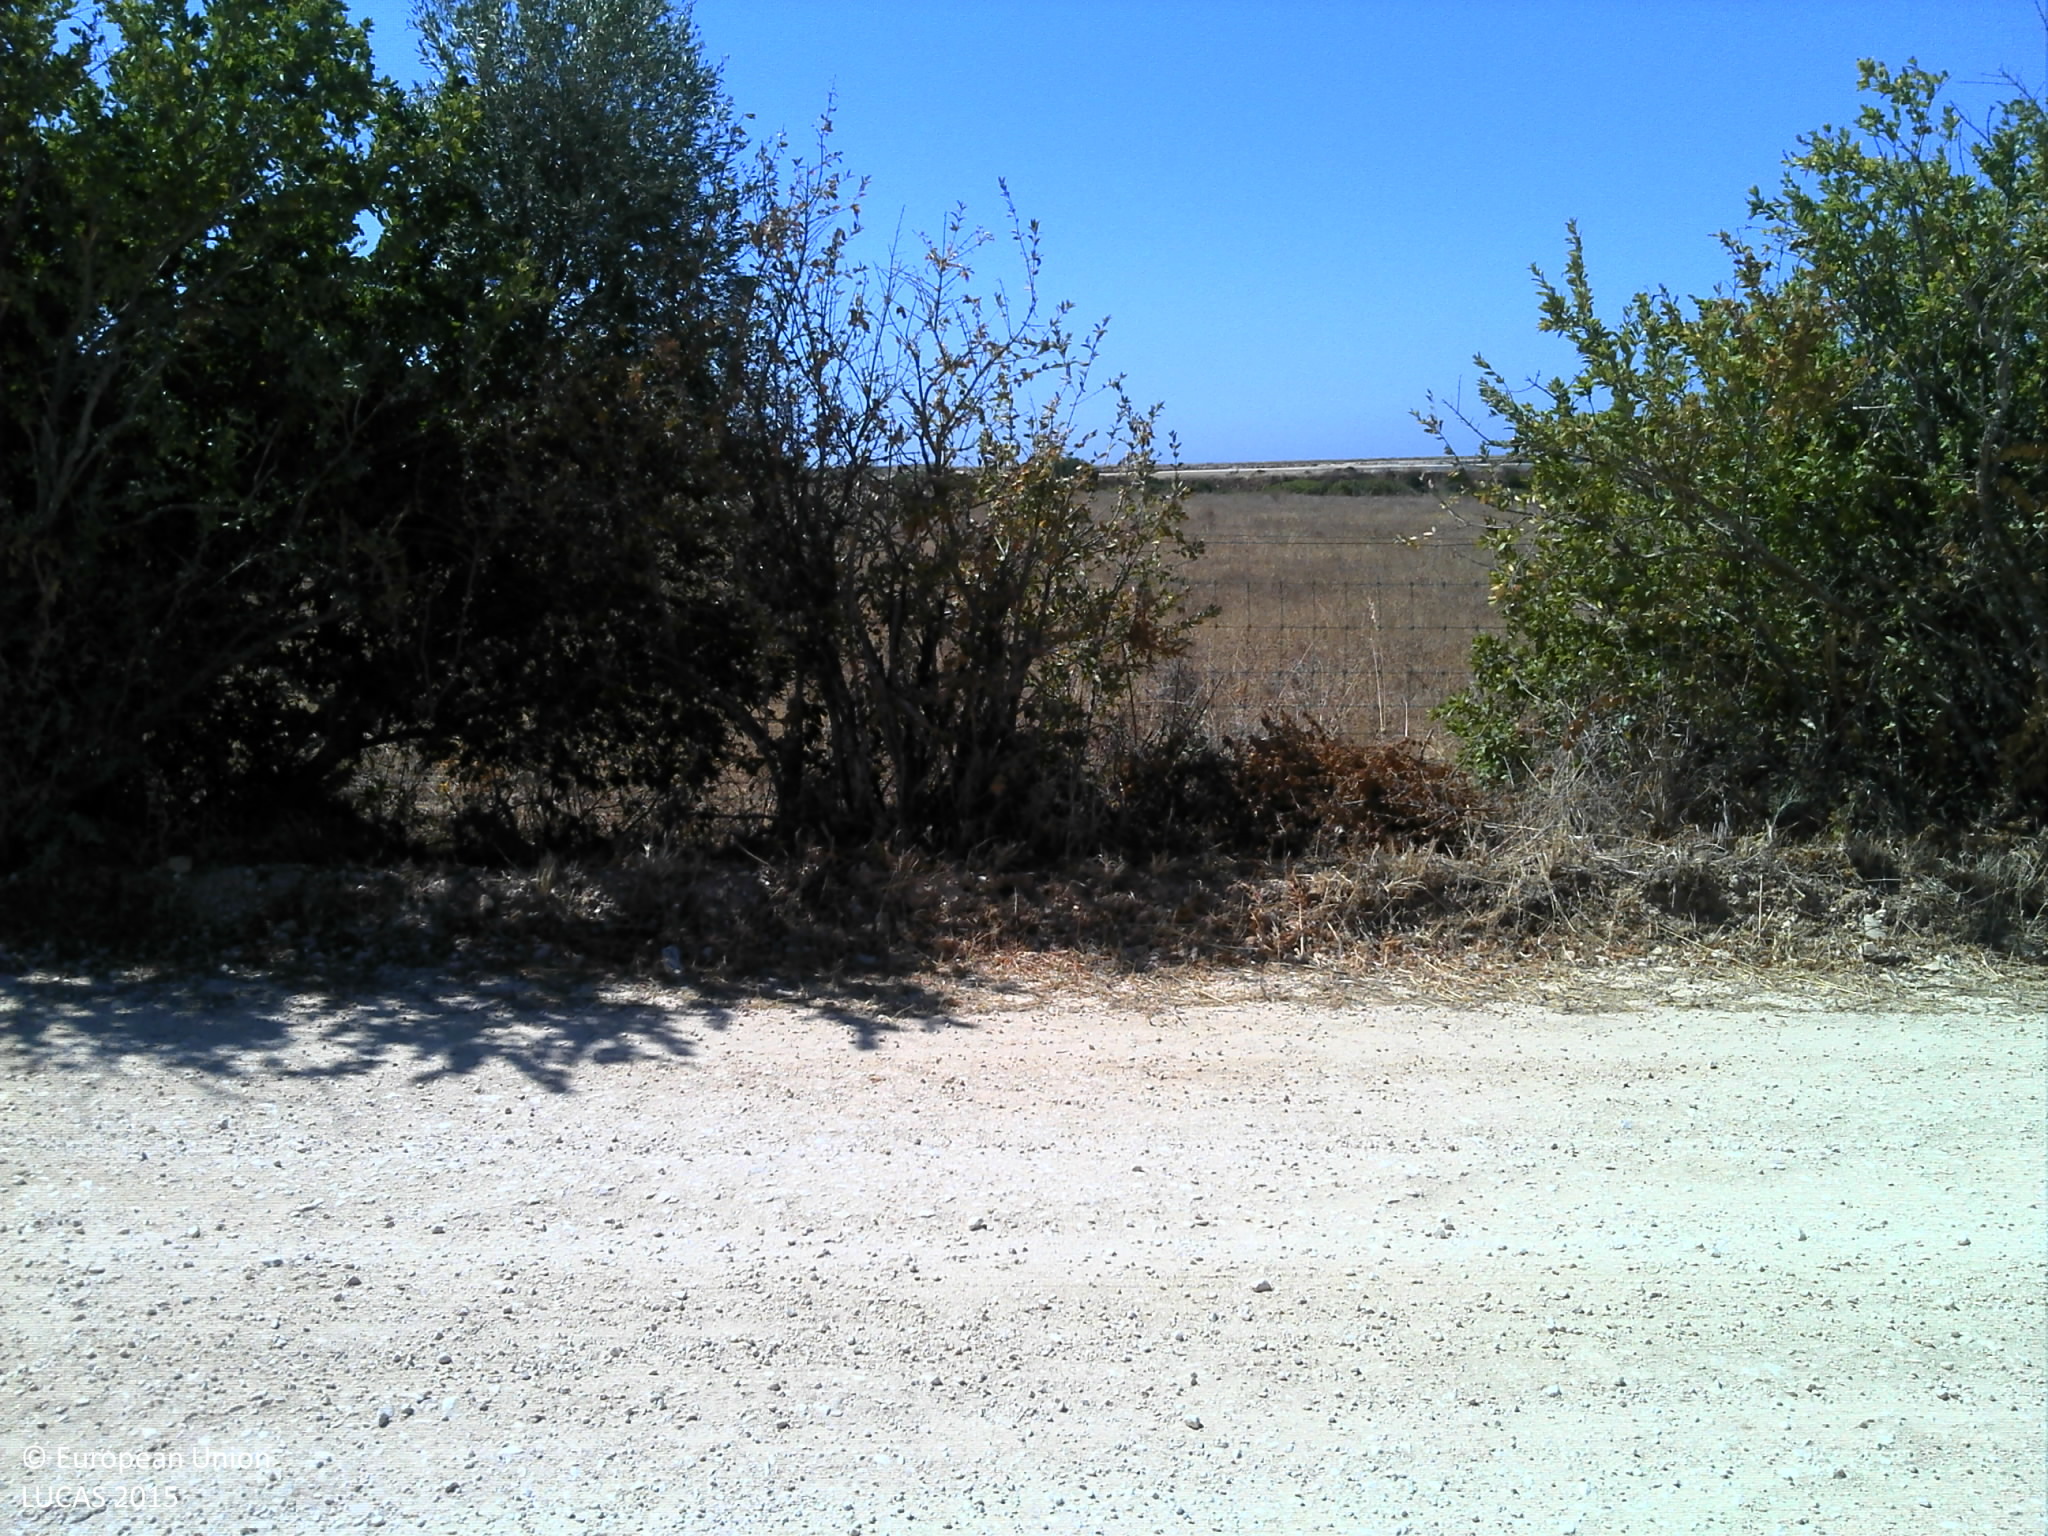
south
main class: Cropland
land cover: Oranges
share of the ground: 10 - 25 %
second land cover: Grassland without tree/shrub cover
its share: 10 - 25 %
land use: Agriculture (excluding fallow land and kitchen gardens)
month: July
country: PT
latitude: 37.1348
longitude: -8.6124
